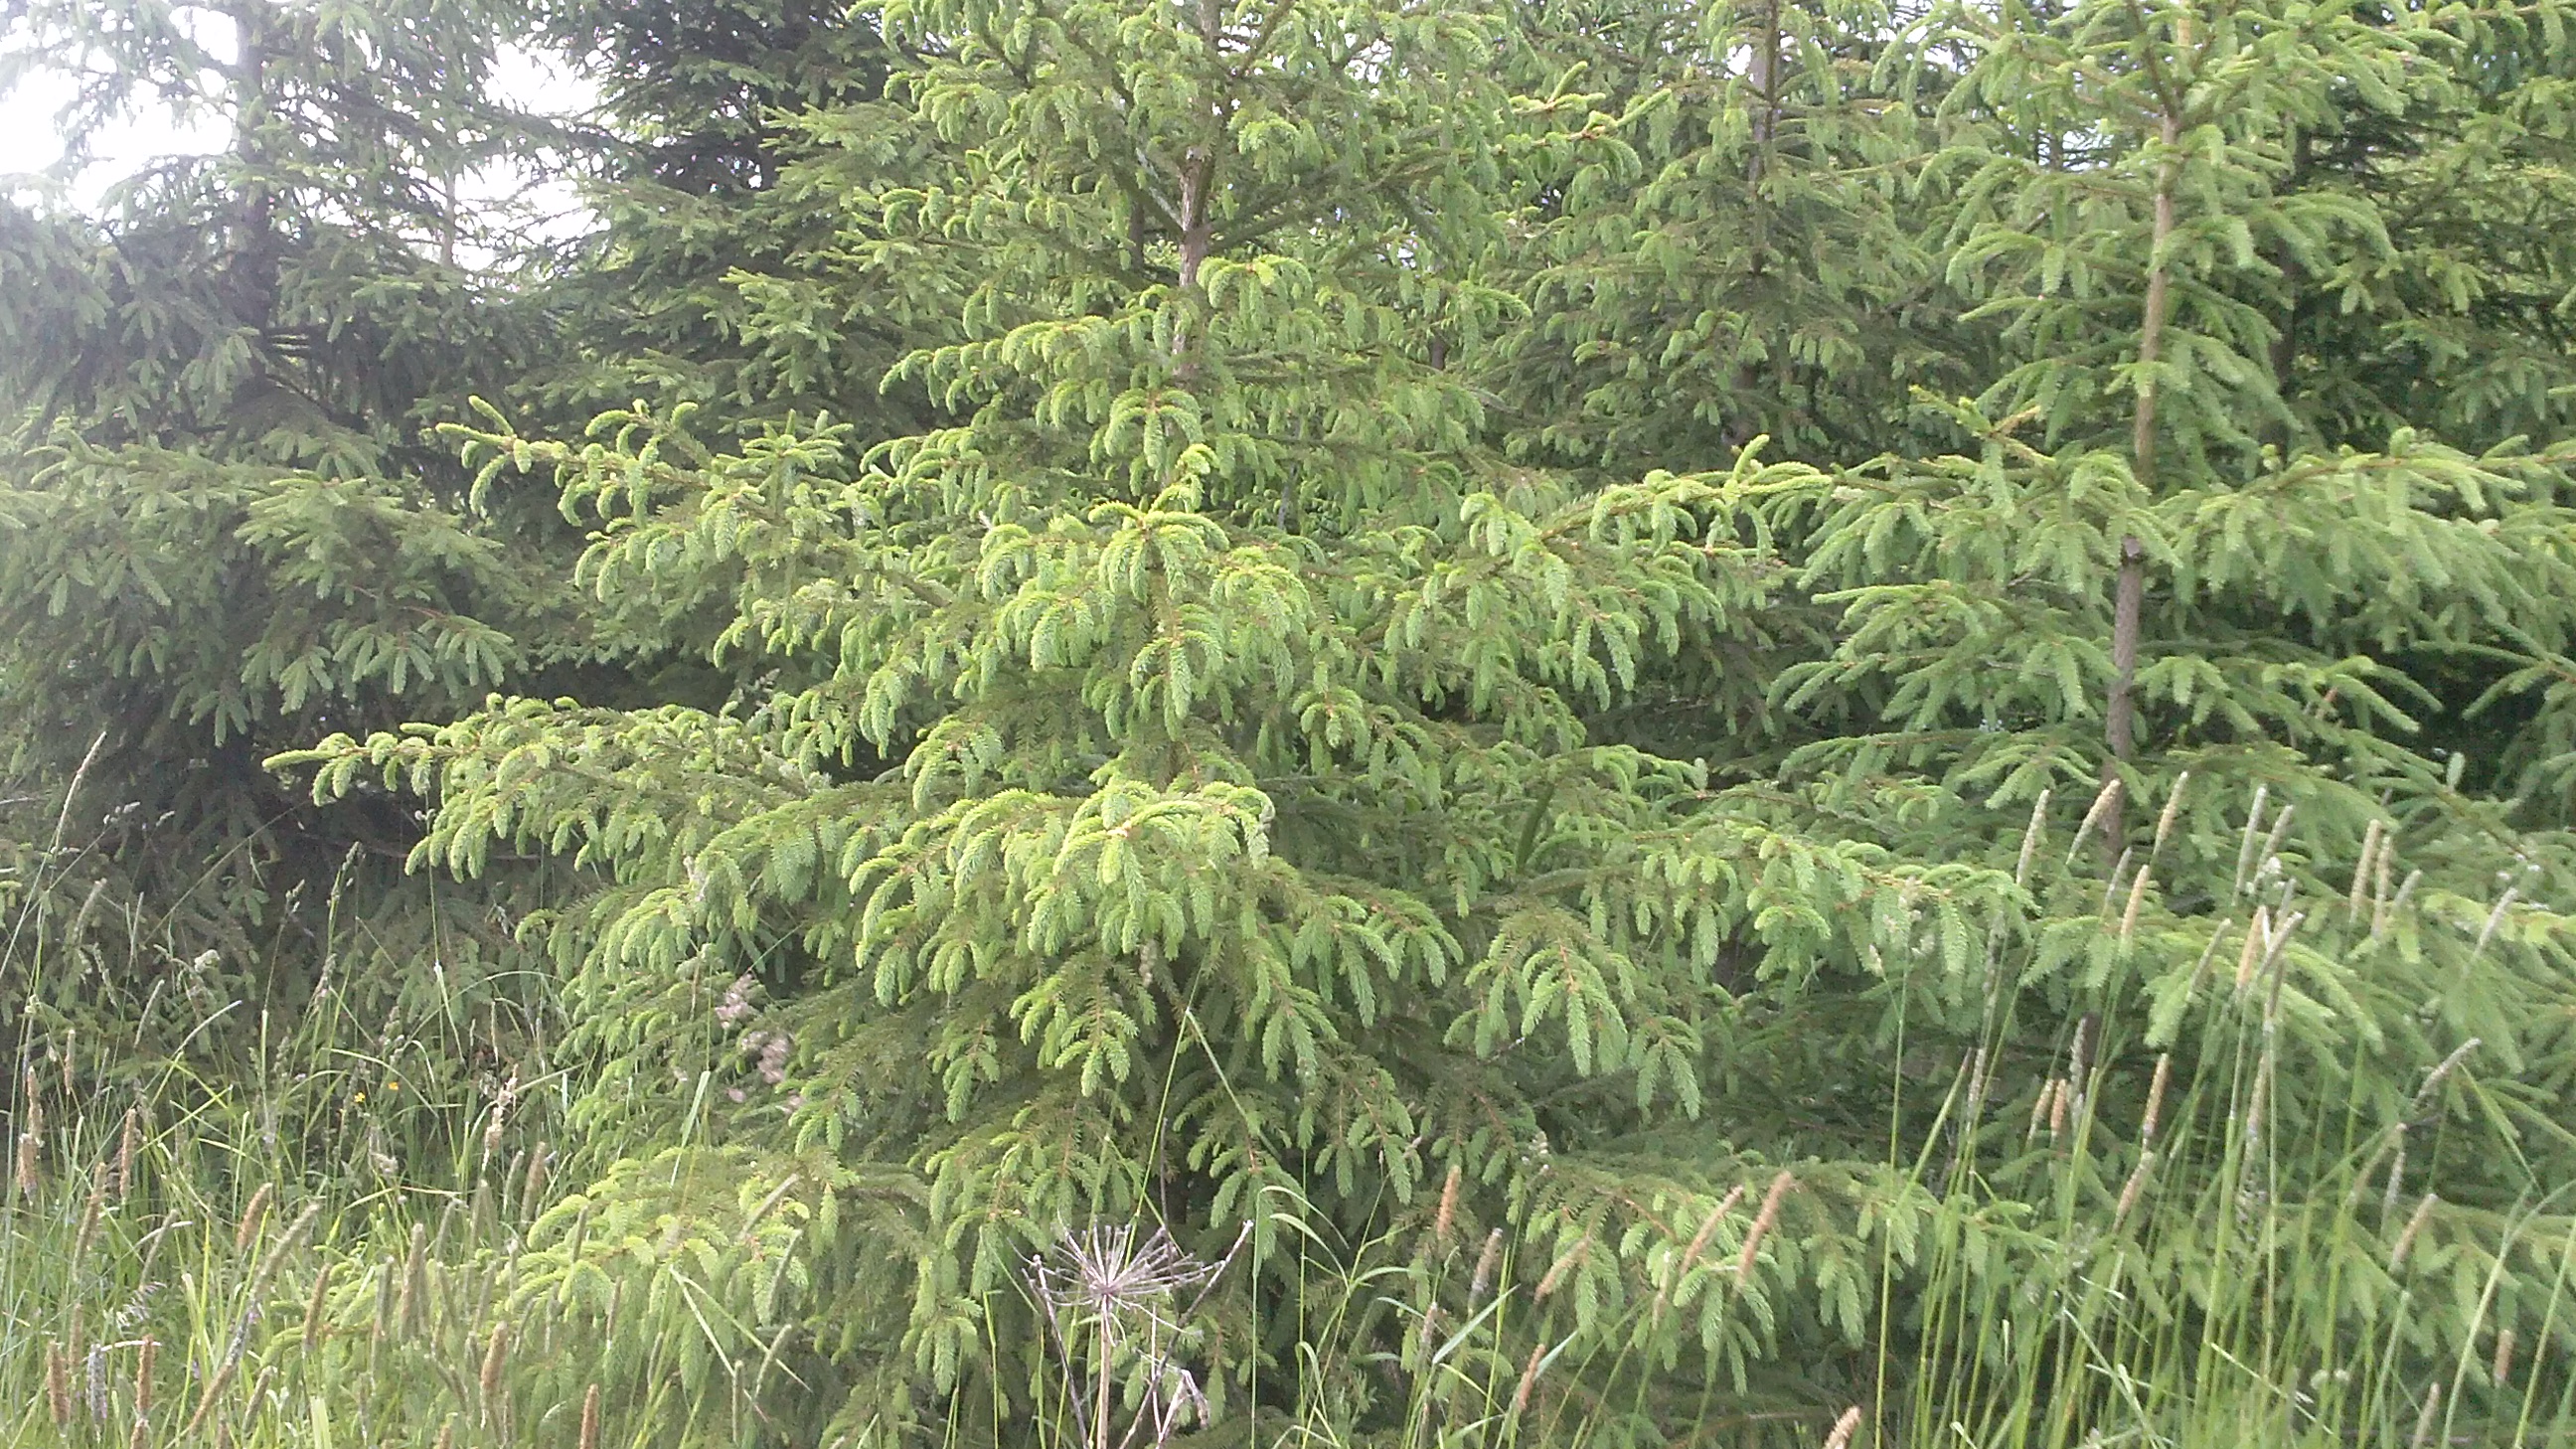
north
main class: Woodland
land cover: Spruce dominated coniferous woodland
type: hemiboreal forest and nemoral coniferous forest and mixed broadleaved-coniferous forest
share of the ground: > 75 %
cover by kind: coniferous forest trees 80 %, herbaceous plants 20 %
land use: Forestry
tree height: < 5 m
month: June
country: LV
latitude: 56.4356
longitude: 27.4499
